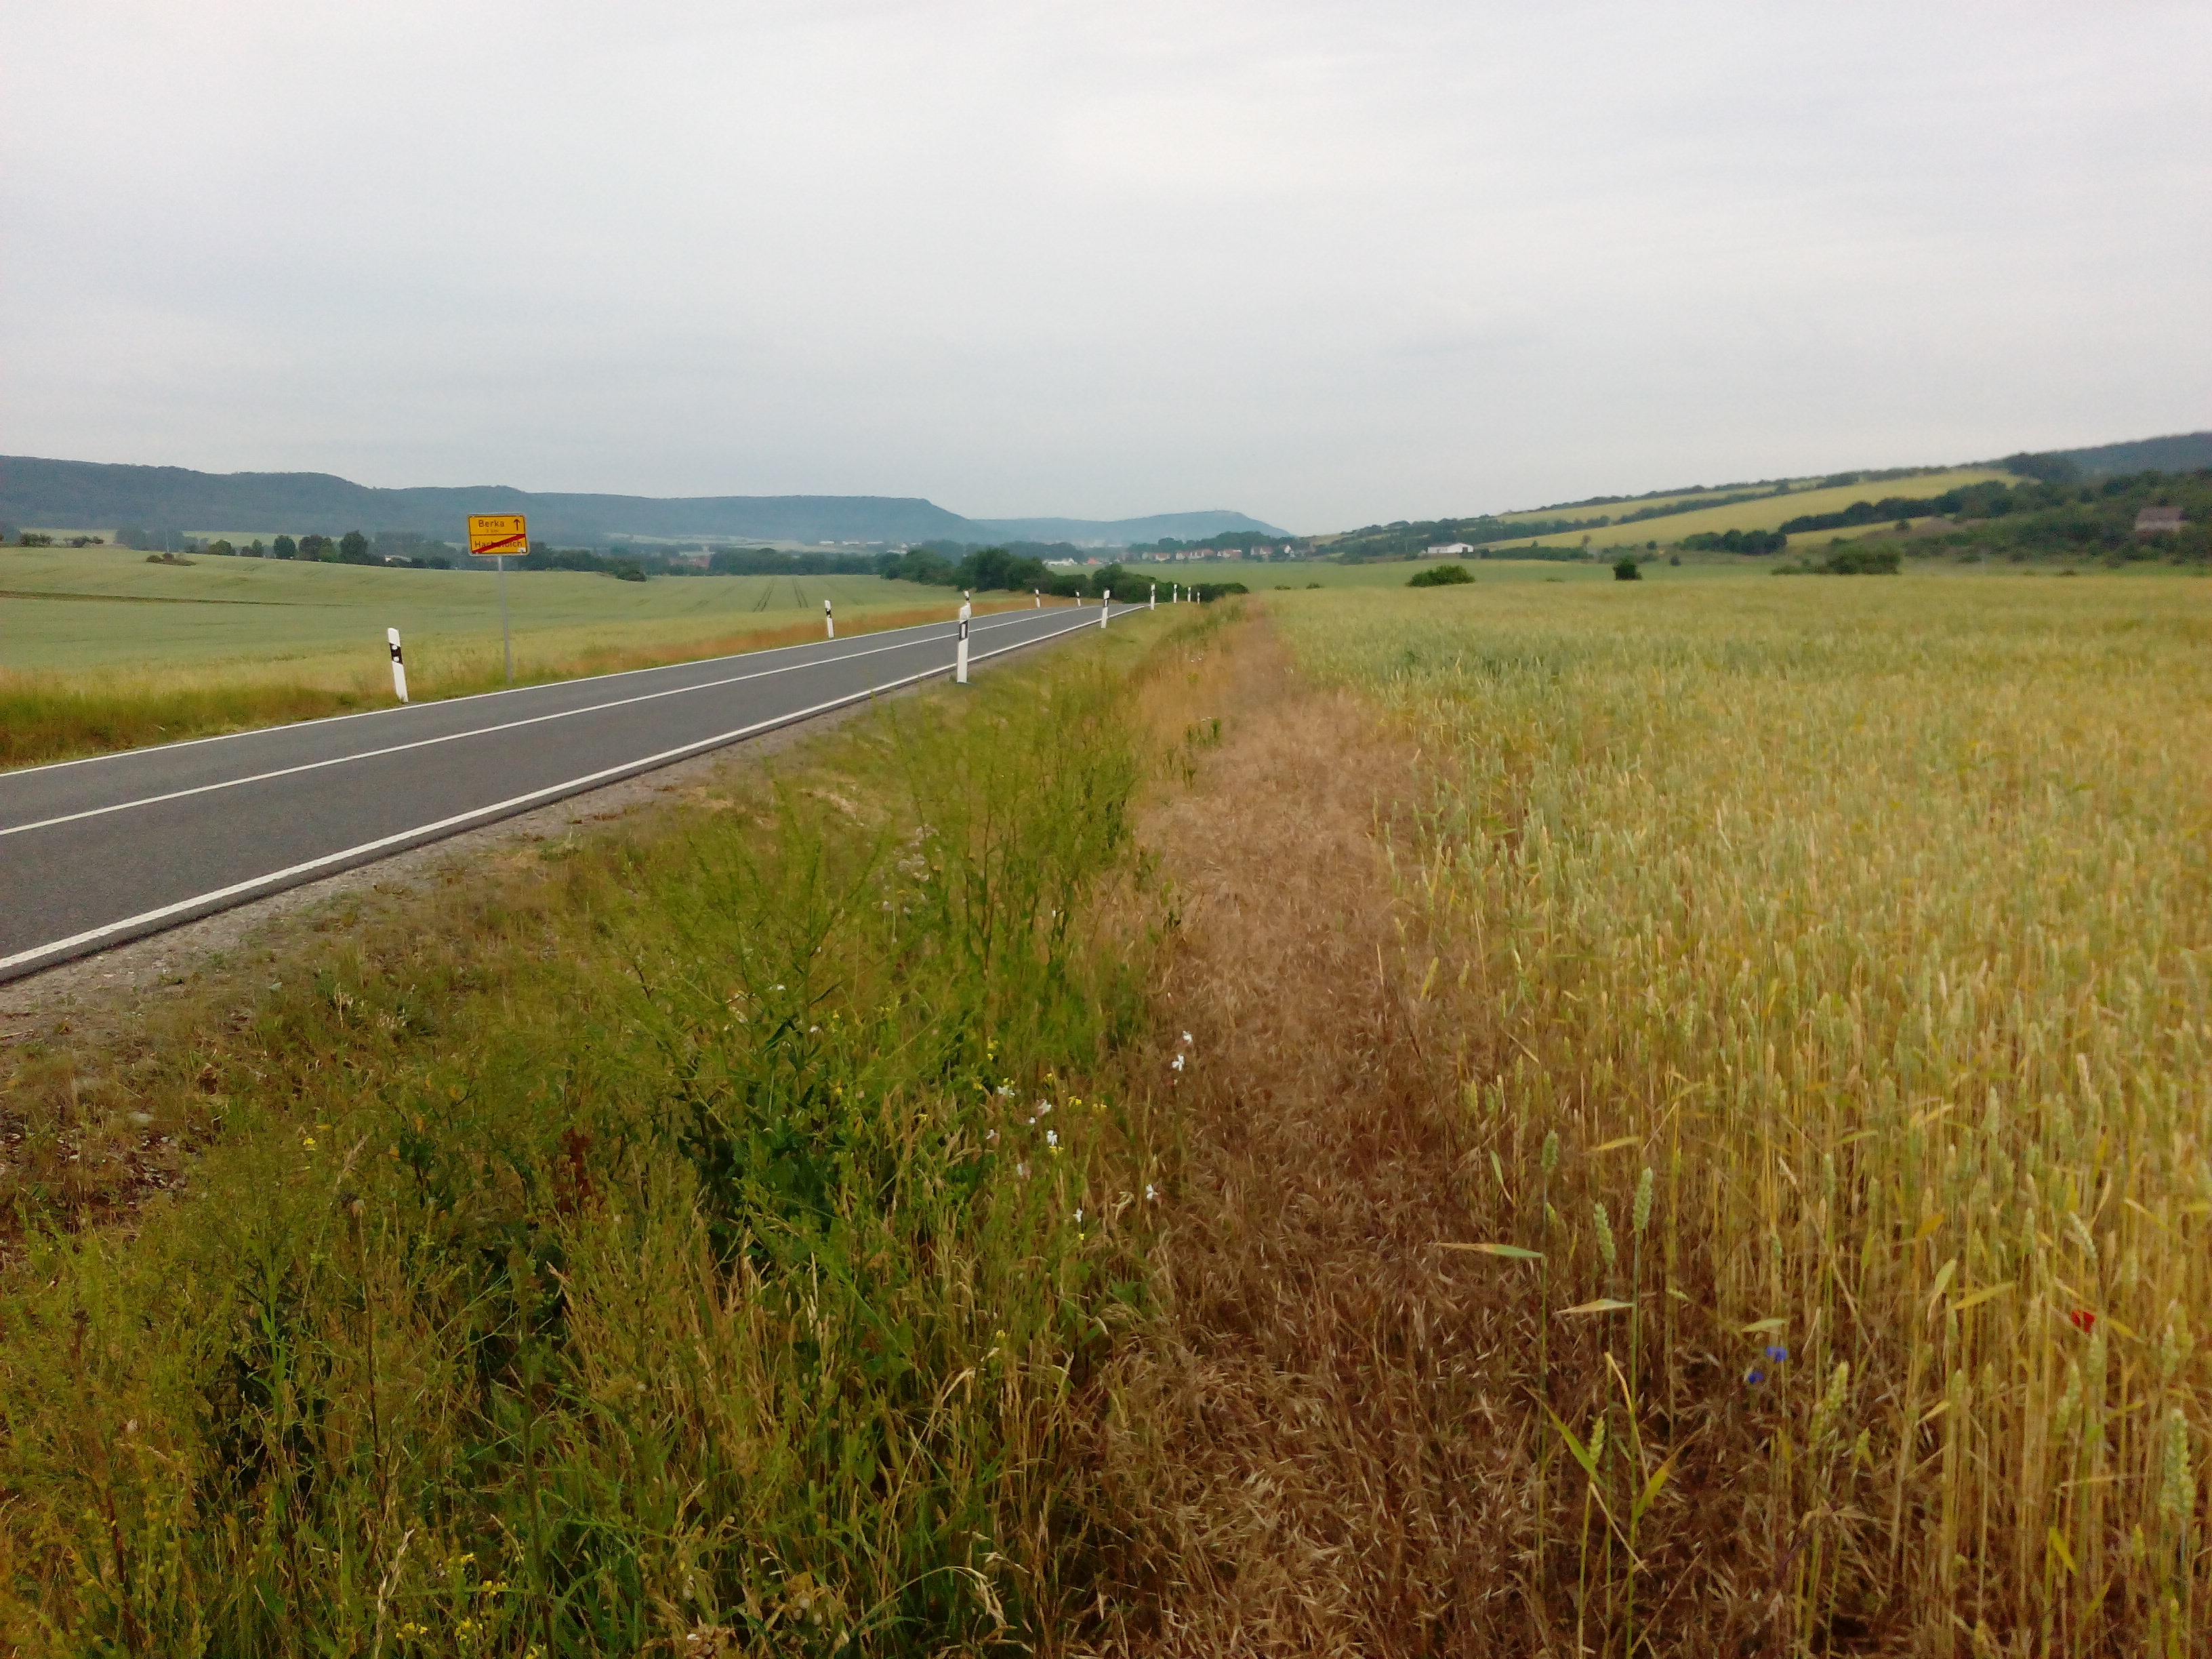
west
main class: Cropland
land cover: Common wheat
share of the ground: > 75 %
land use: Agriculture (excluding fallow land and kitchen gardens)
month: June
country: DE
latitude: 51.3489
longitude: 10.9617
